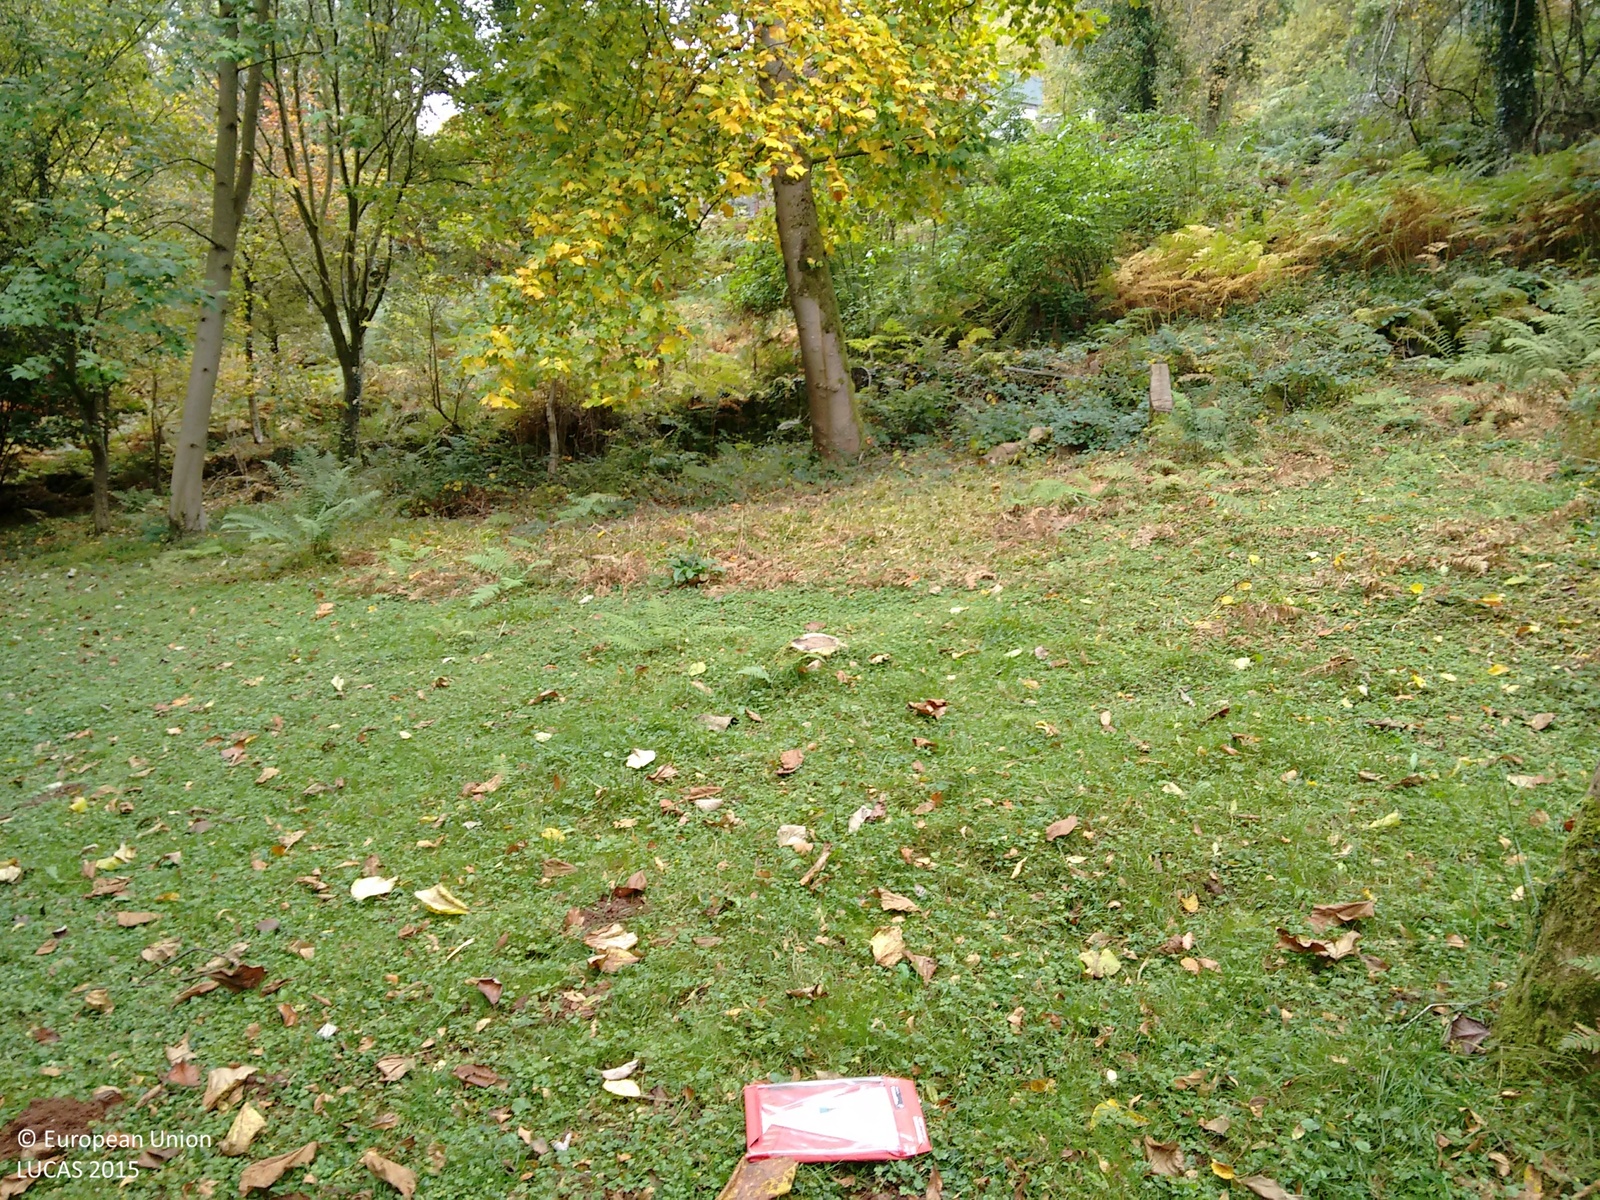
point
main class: Woodland
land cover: Broadleaved woodland
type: mesophytic deciduous forest
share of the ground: > 75 %
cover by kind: broadleaved forest trees 60 %, shrubs 20 %, herbaceous plants 20 %
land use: Residential
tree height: > 5 m
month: October
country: GB
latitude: 51.7335
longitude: -2.6520
